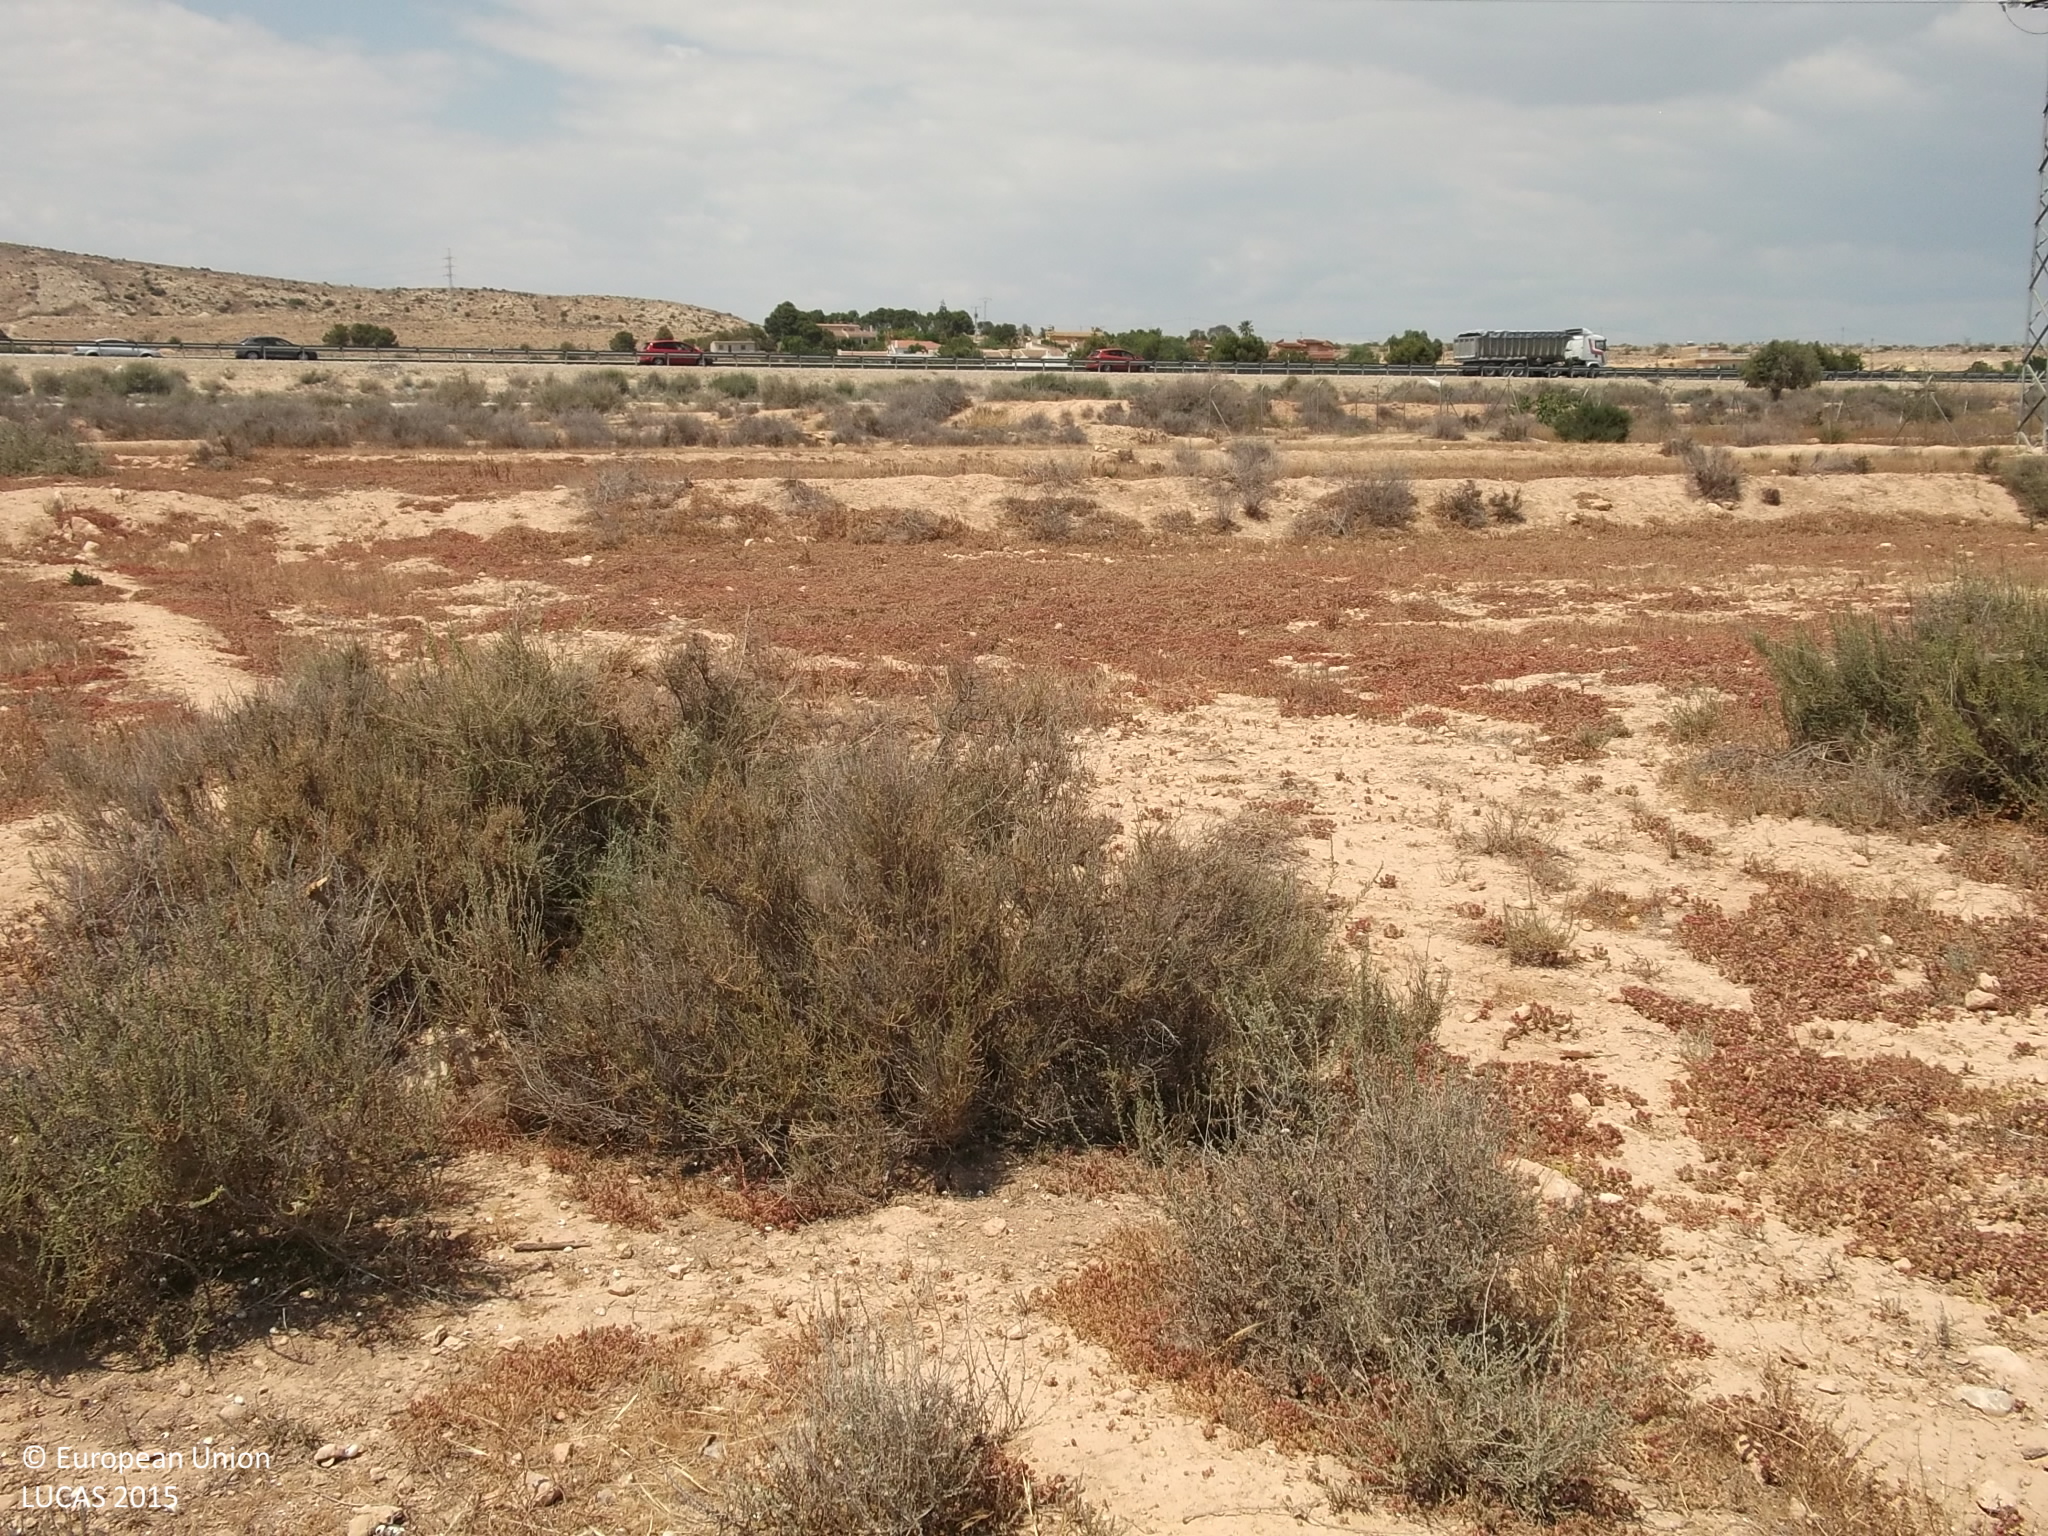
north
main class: Grassland
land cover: Grassland without tree/shrub cover
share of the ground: 50 - 75 %
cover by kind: herbaceous plants 60 %, unconsolidated bare surface 40 %
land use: Abandoned areas
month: May
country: ES
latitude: 38.3010
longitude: -0.6314
